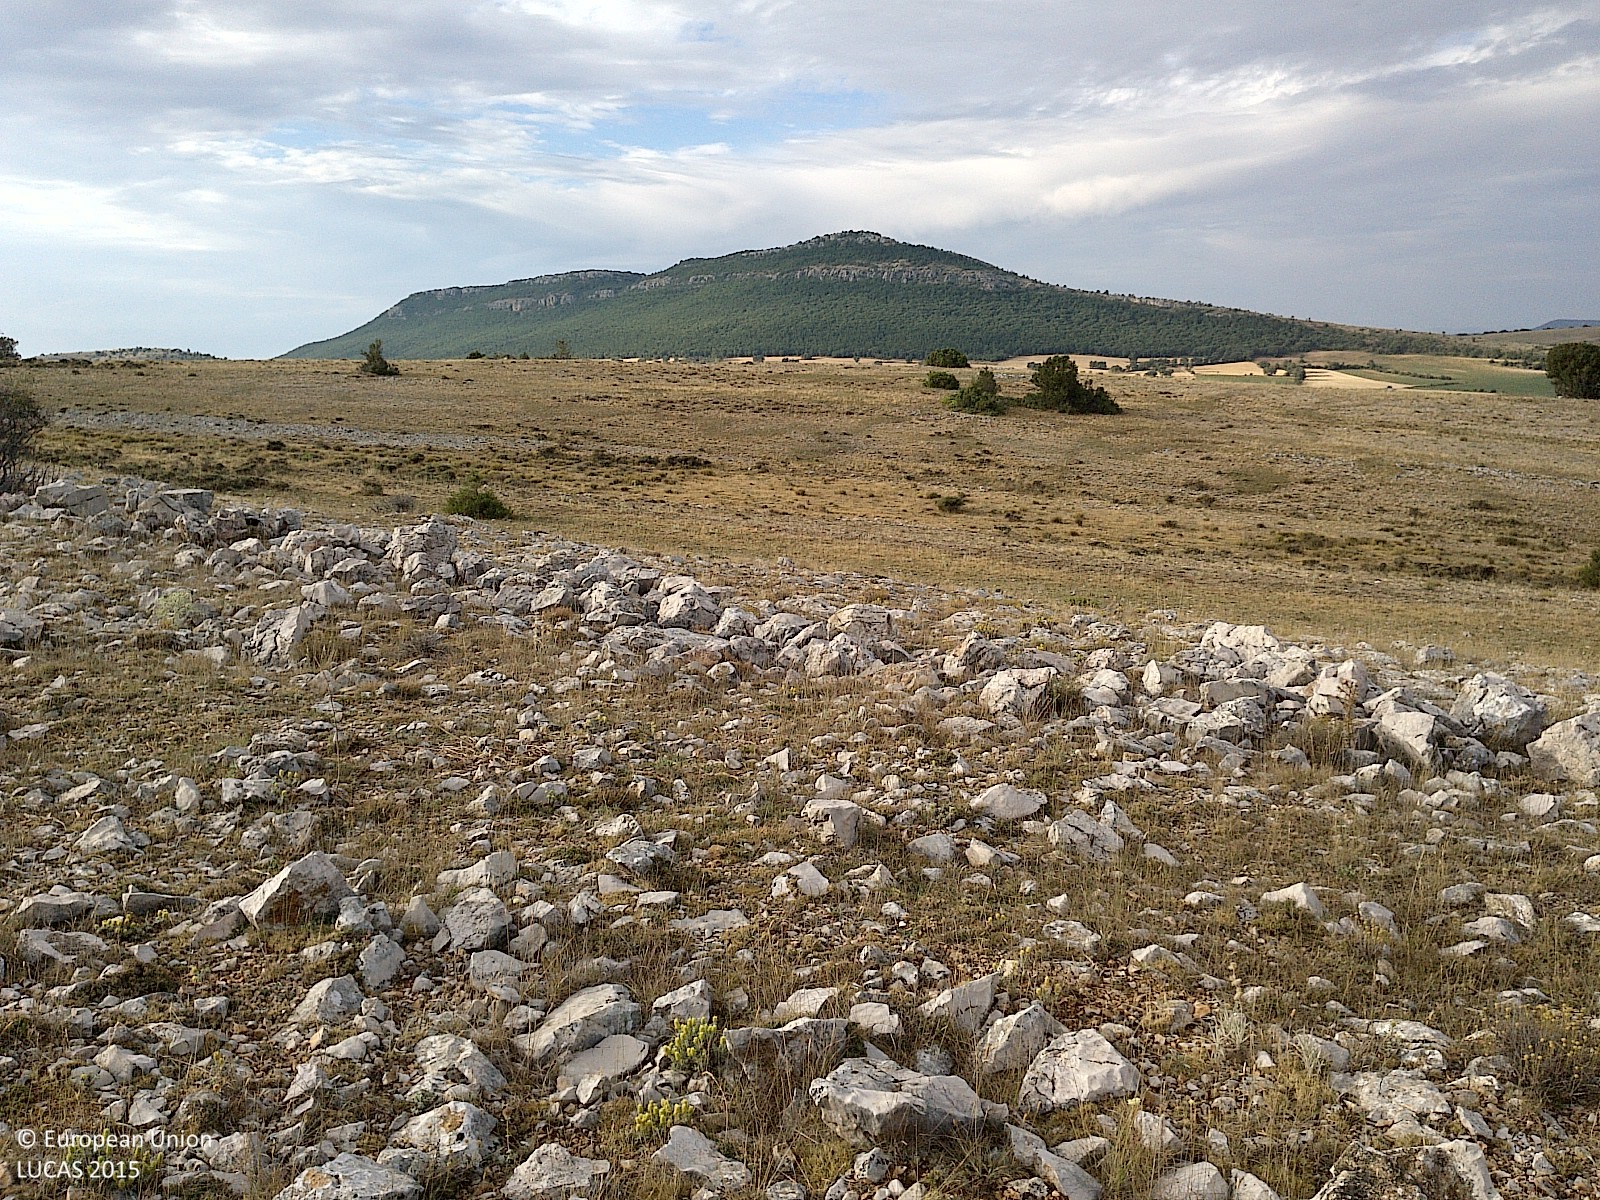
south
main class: Grassland
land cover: Grassland without tree/shrub cover
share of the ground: 25 - 50 %
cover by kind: unconsolidated bare surface 65 %, herbaceous plants 30 %, lichens and mosses 5 %
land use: Agriculture (excluding fallow land and kitchen gardens)
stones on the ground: > 50 %
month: July
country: ES
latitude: 41.6279
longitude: -1.9986
